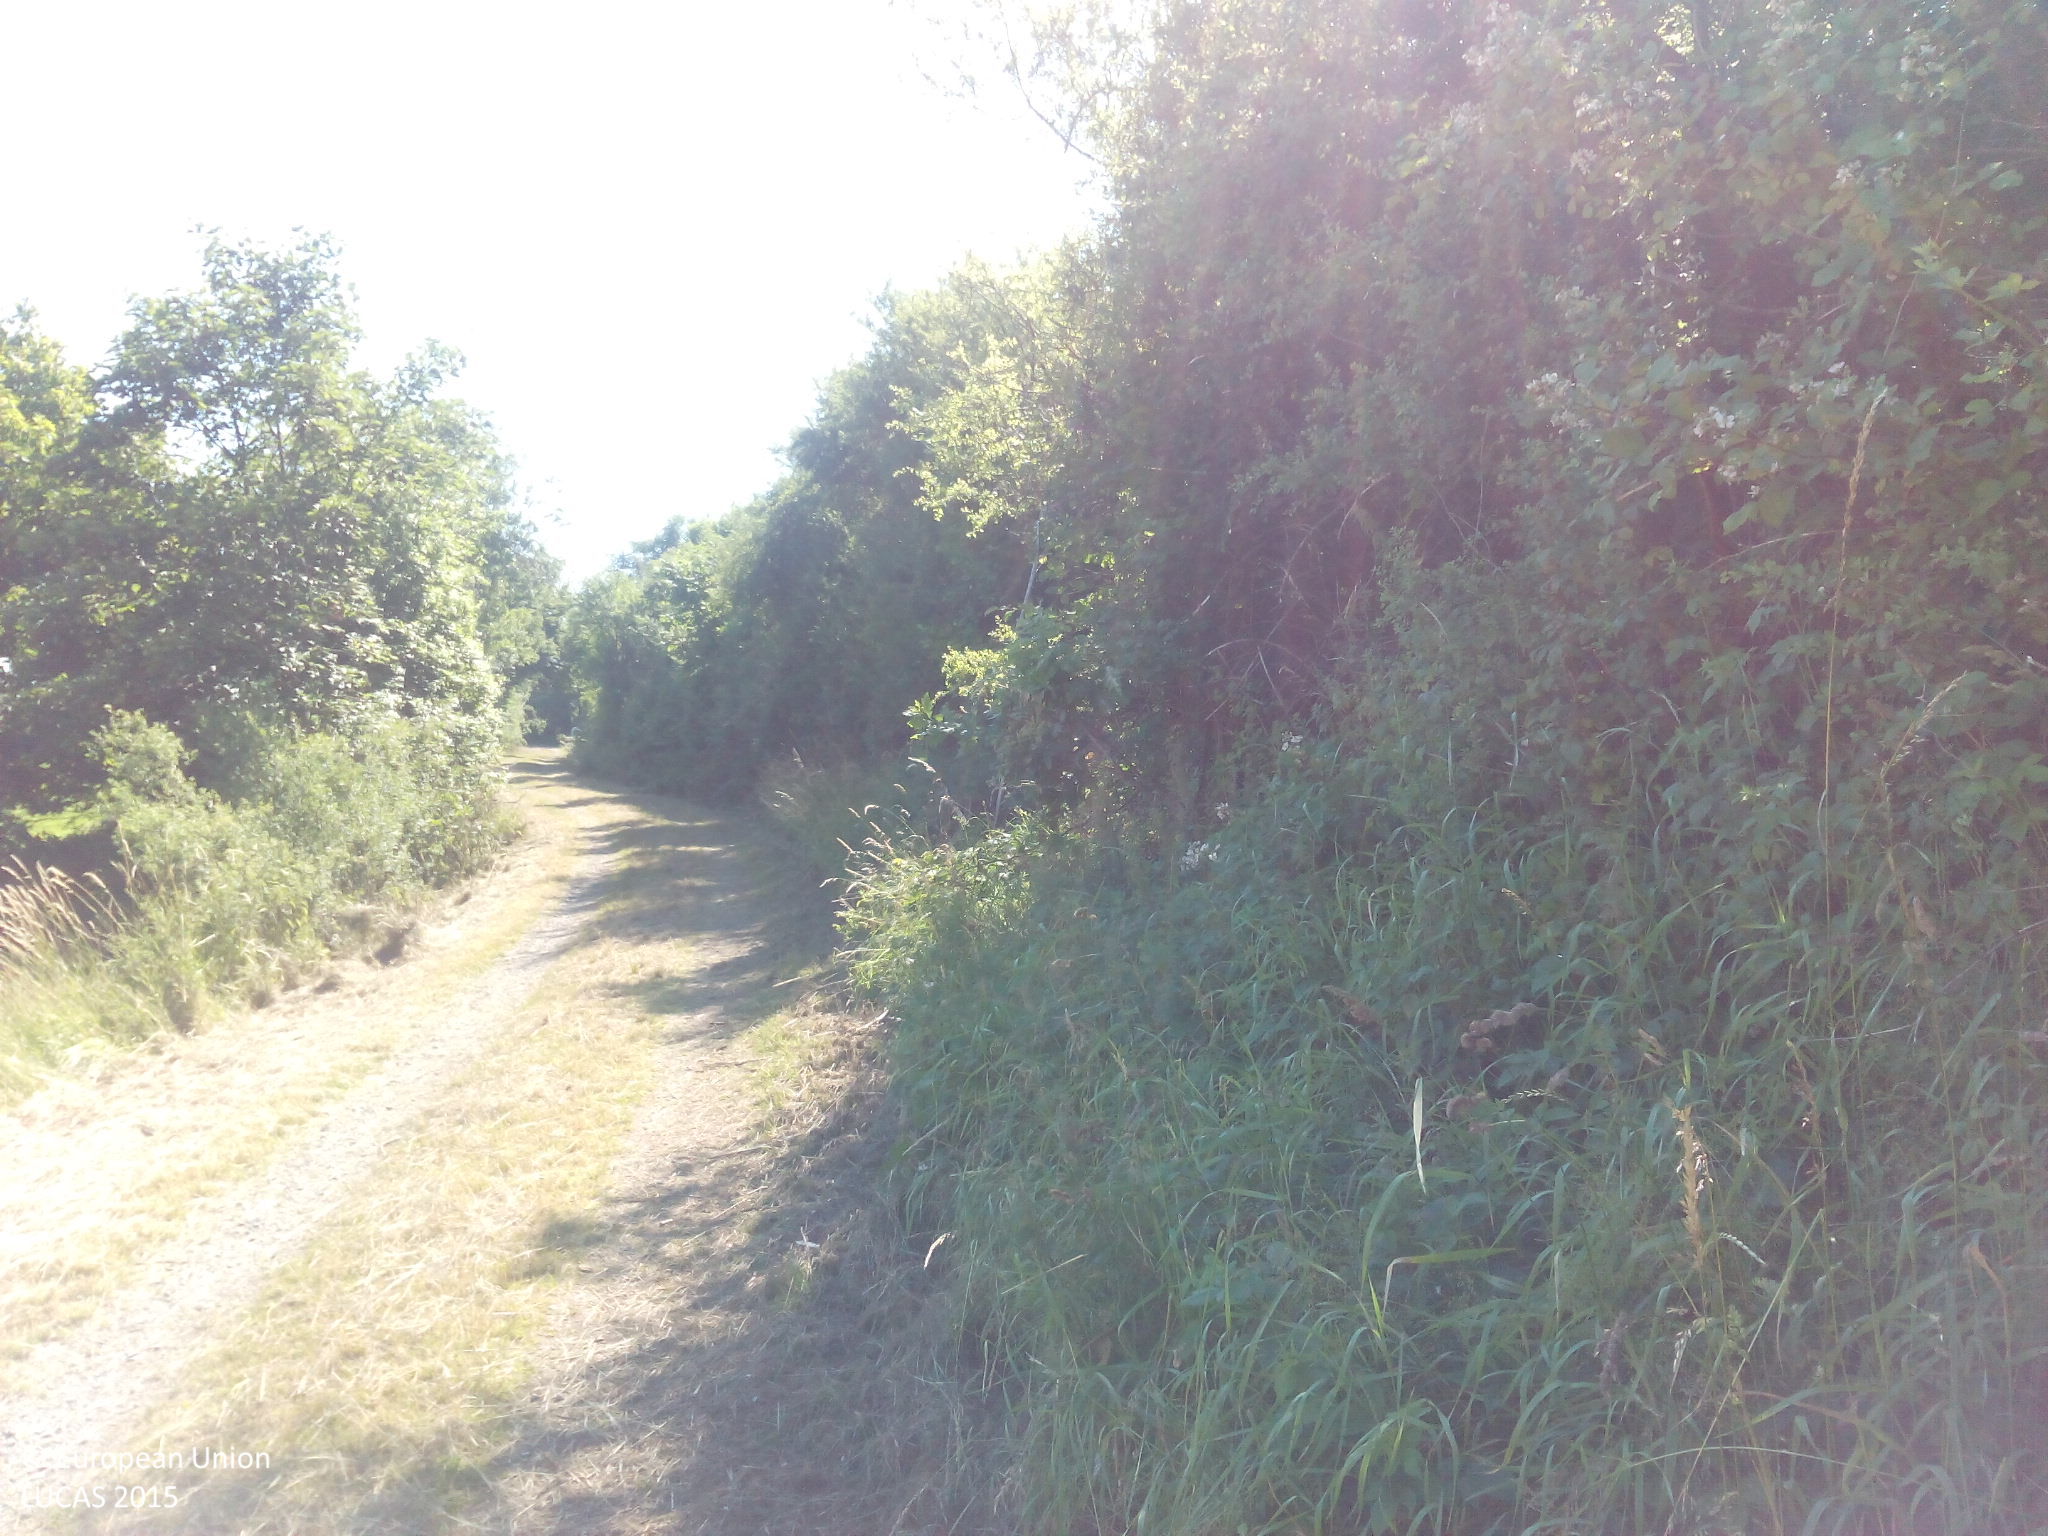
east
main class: Woodland
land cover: Broadleaved woodland
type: acidophilous oak and oak-birch forest
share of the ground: 50 - 75 %
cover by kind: broadleaved forest trees 60 %, shrubs 40 %
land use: Abandoned areas
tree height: < 5 m
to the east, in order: Broadleaved woodland; Tracks; Grassland without tree/shrub cover; Broadleaved woodland; Grass margins; Paved roads, cycling and walking lanes; Shrubland with sparse tree cover; Broadleaved woodland; Shruby margins; Grassland without tree/shrub cover
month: July
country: DE
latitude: 49.5283
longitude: 7.5550
